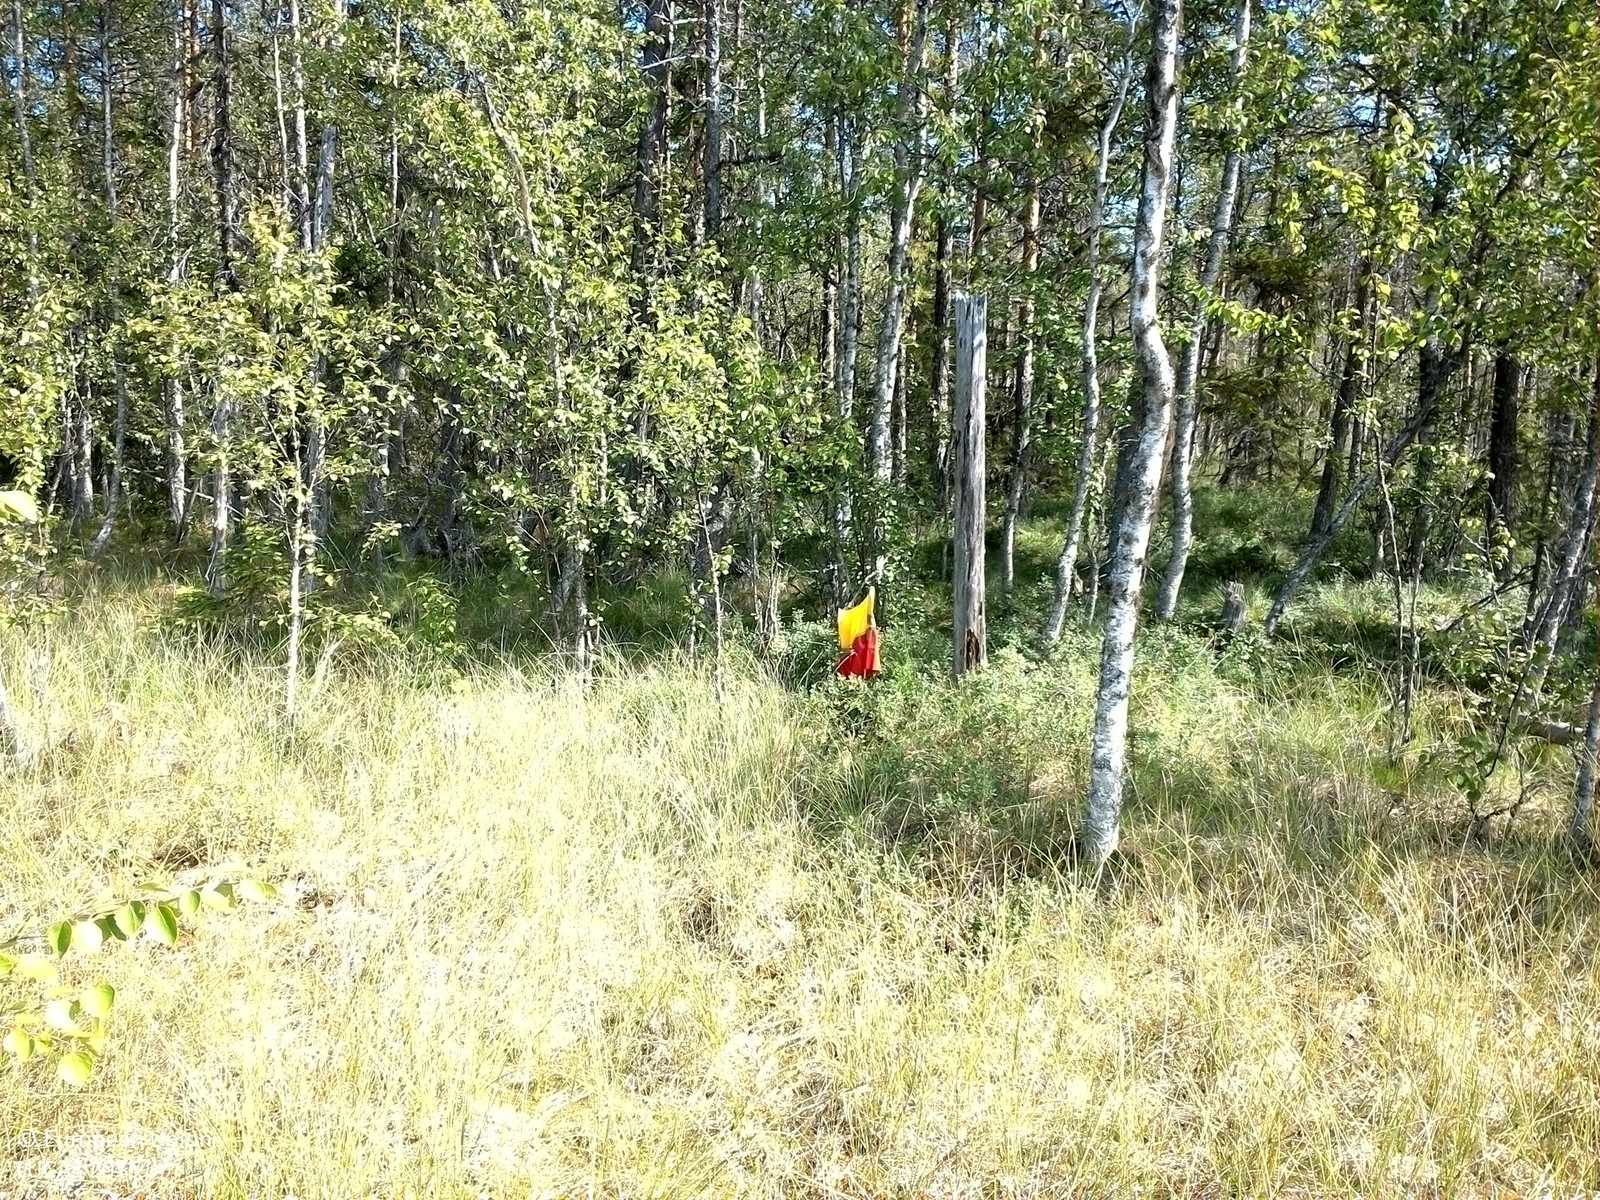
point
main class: Woodland
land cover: Pine dominated mixed woodland
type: mire and swamp forests
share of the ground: 50 - 75 %
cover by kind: coniferous forest trees 35 %, broadleaved forest trees 20 %, shrubs 20 %, lichens and mosses 15 %, herbaceous plants 10 %
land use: Forestry
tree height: > 5 m
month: August
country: SE
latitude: 63.7209
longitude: 16.5114
